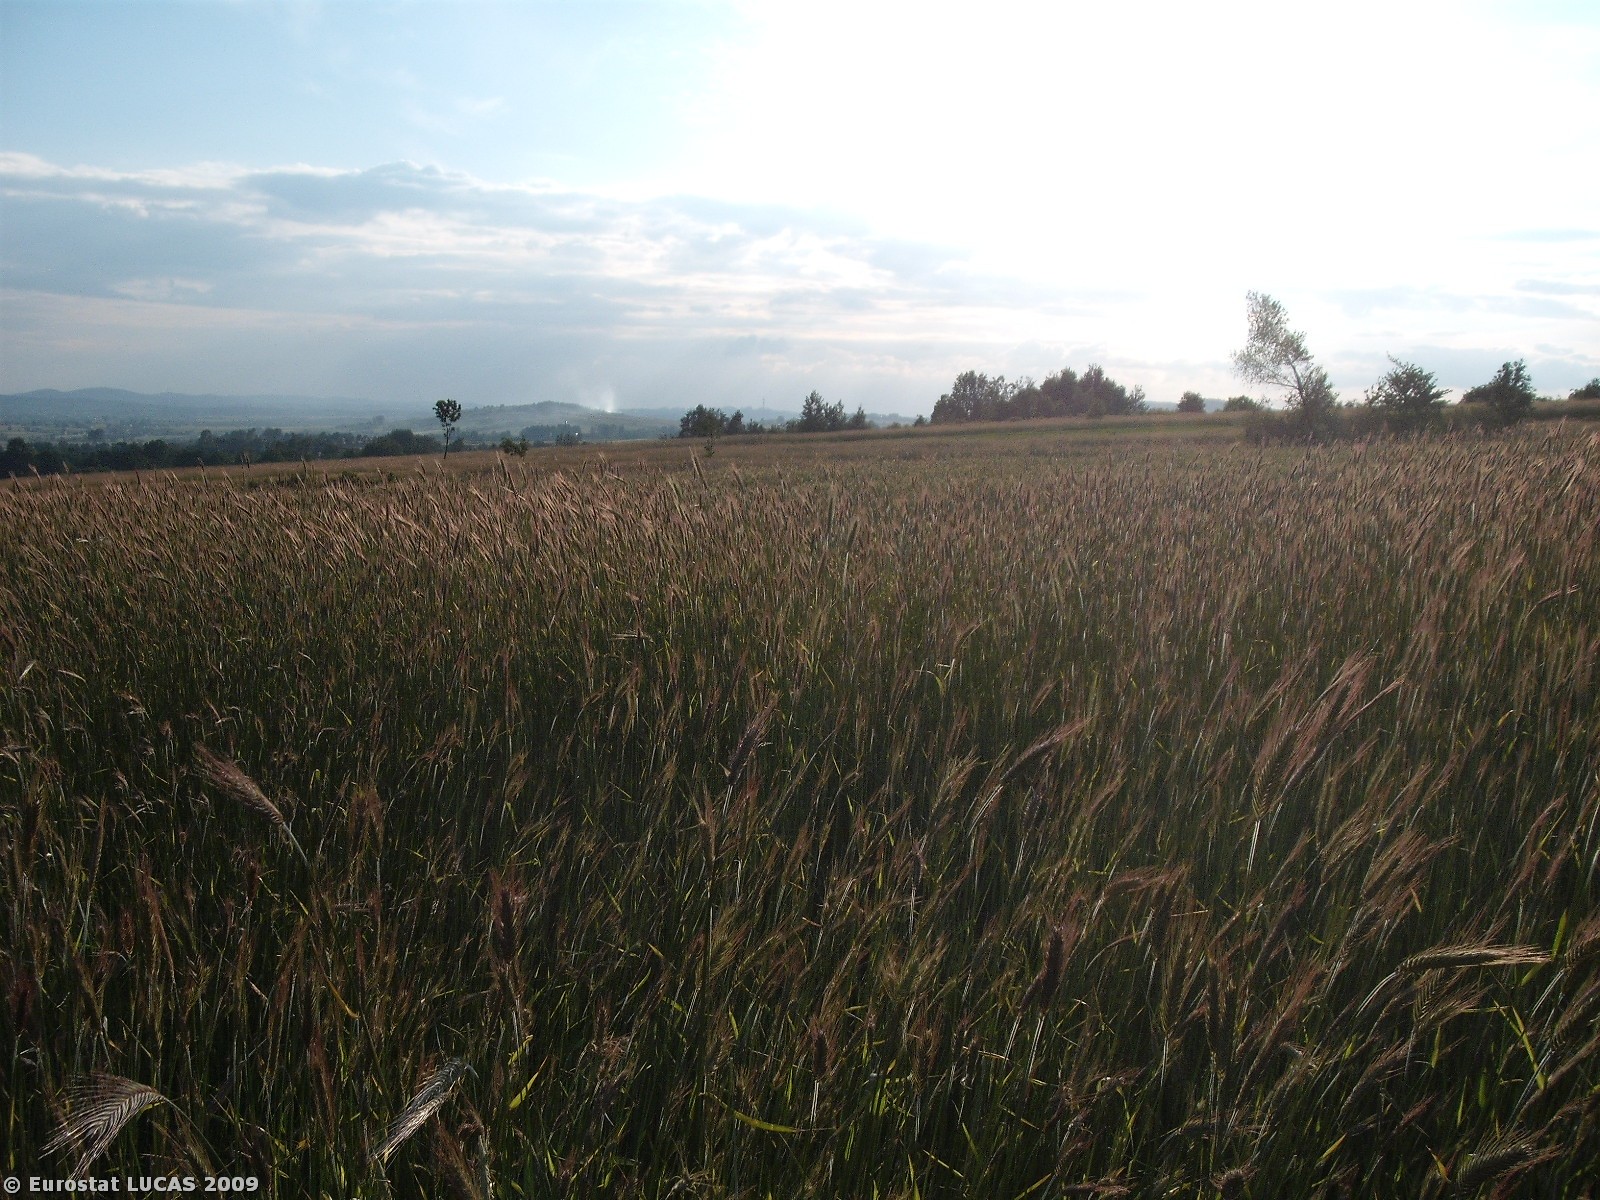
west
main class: Cropland
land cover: Rye
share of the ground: > 75 %
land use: Agriculture (excluding fallow land and kitchen gardens)
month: June
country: PL
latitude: 50.8771
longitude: 20.8867
